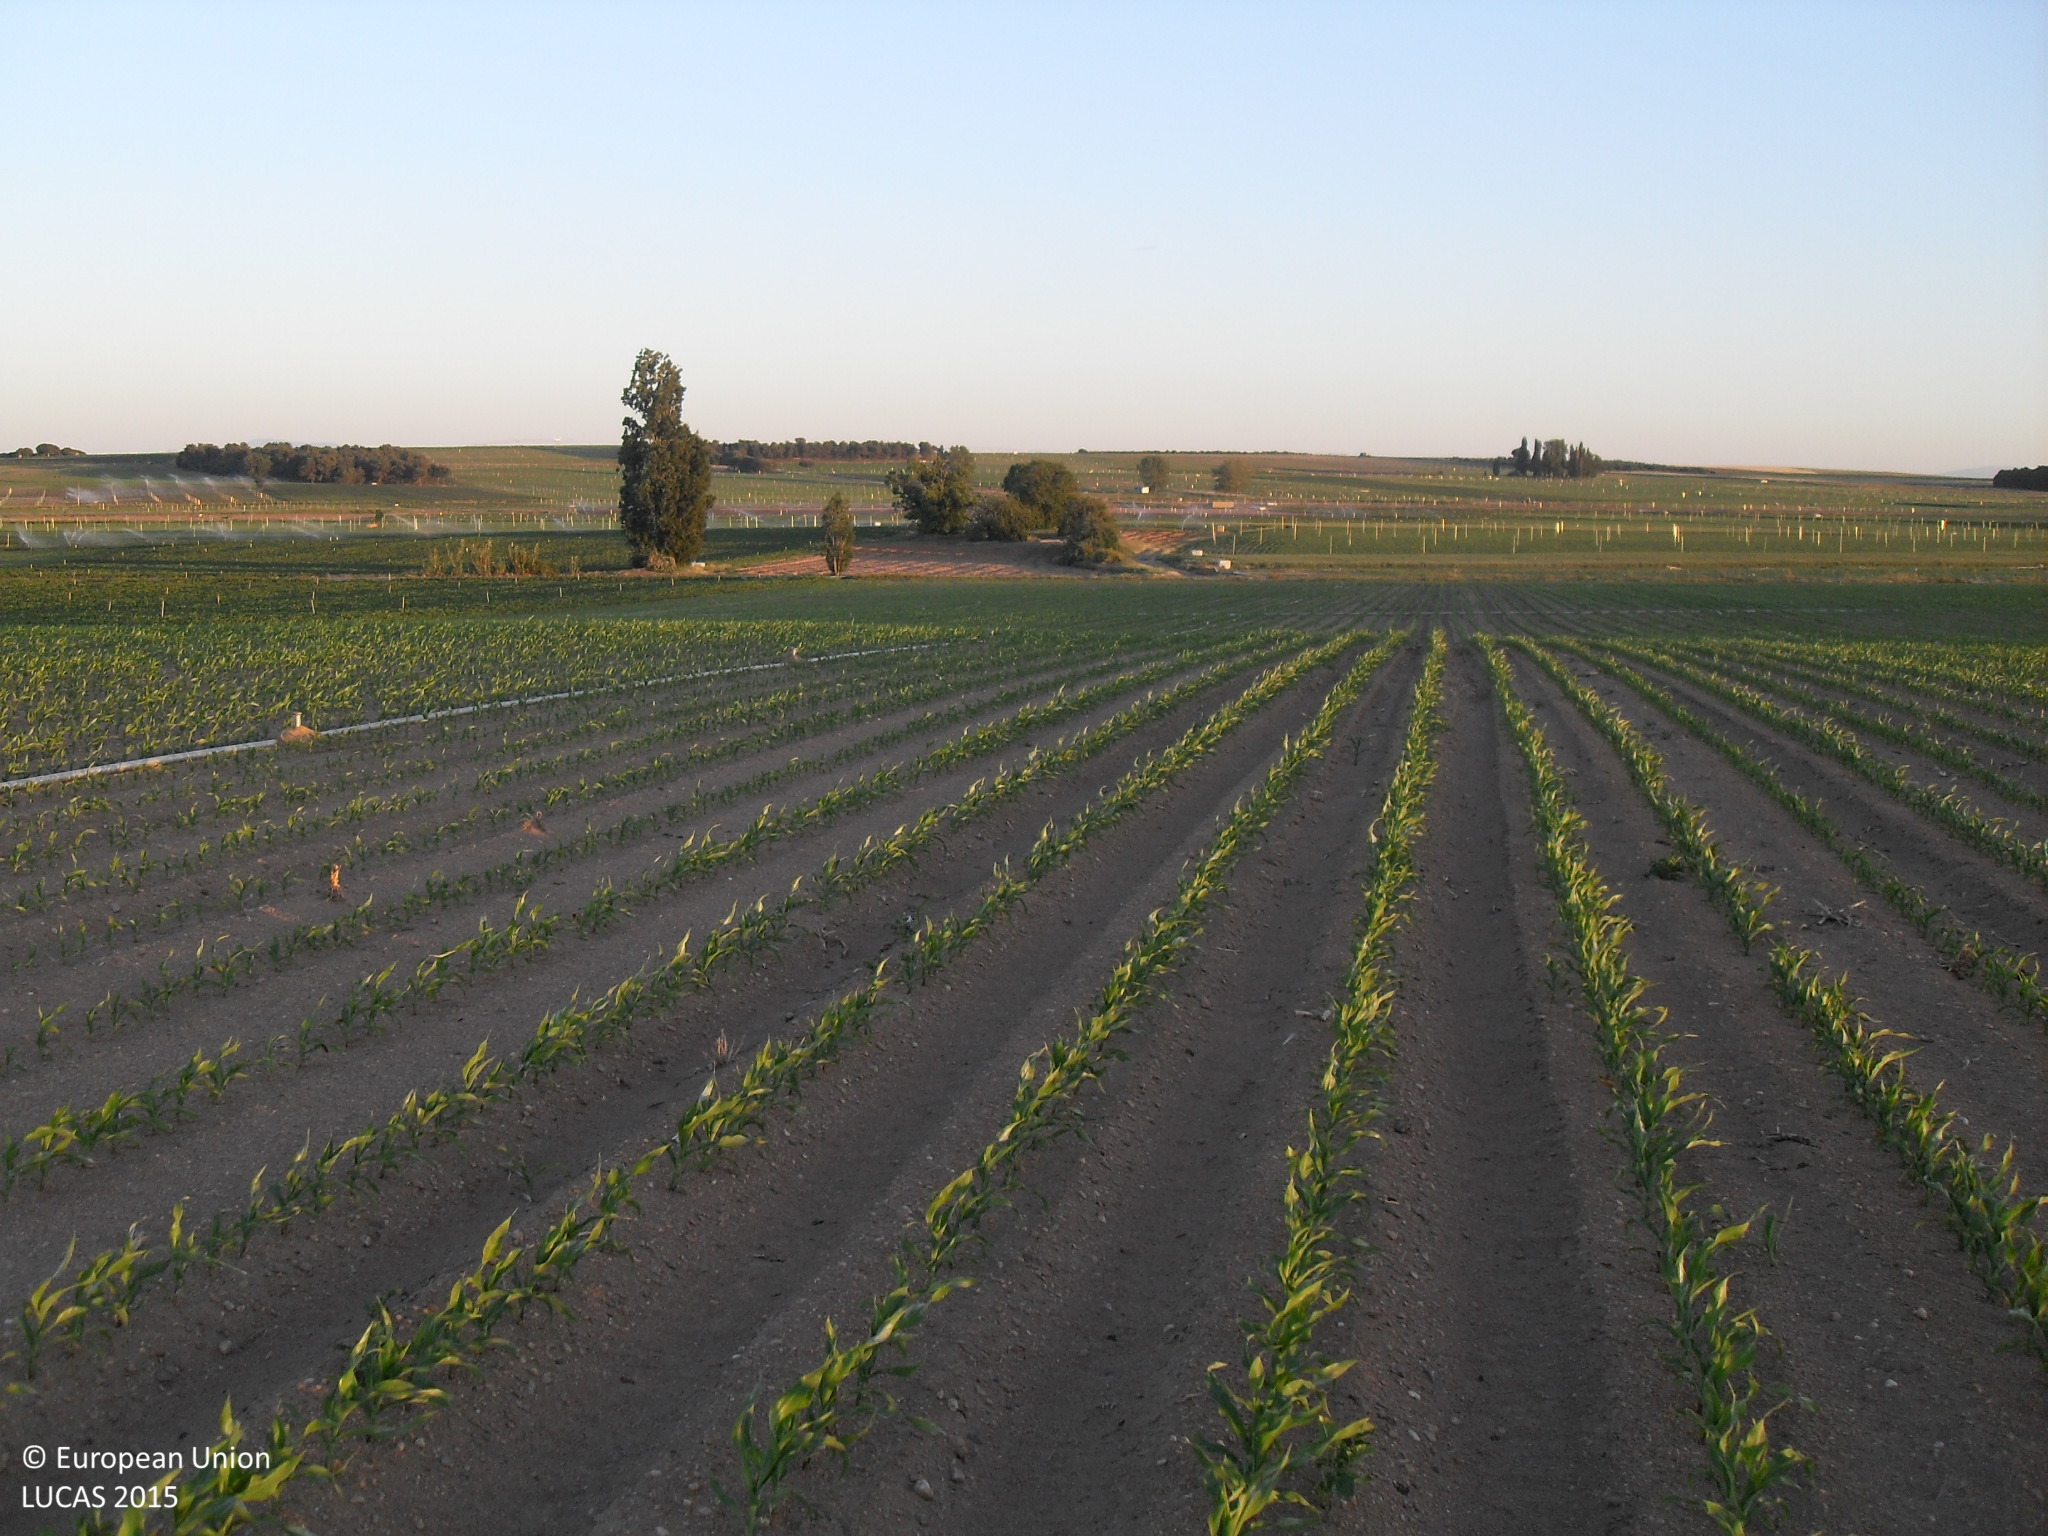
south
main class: Cropland
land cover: Maize
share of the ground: 10 - 25 %
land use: Agriculture (excluding fallow land and kitchen gardens)
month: May
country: ES
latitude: 41.0446
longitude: -5.4080
